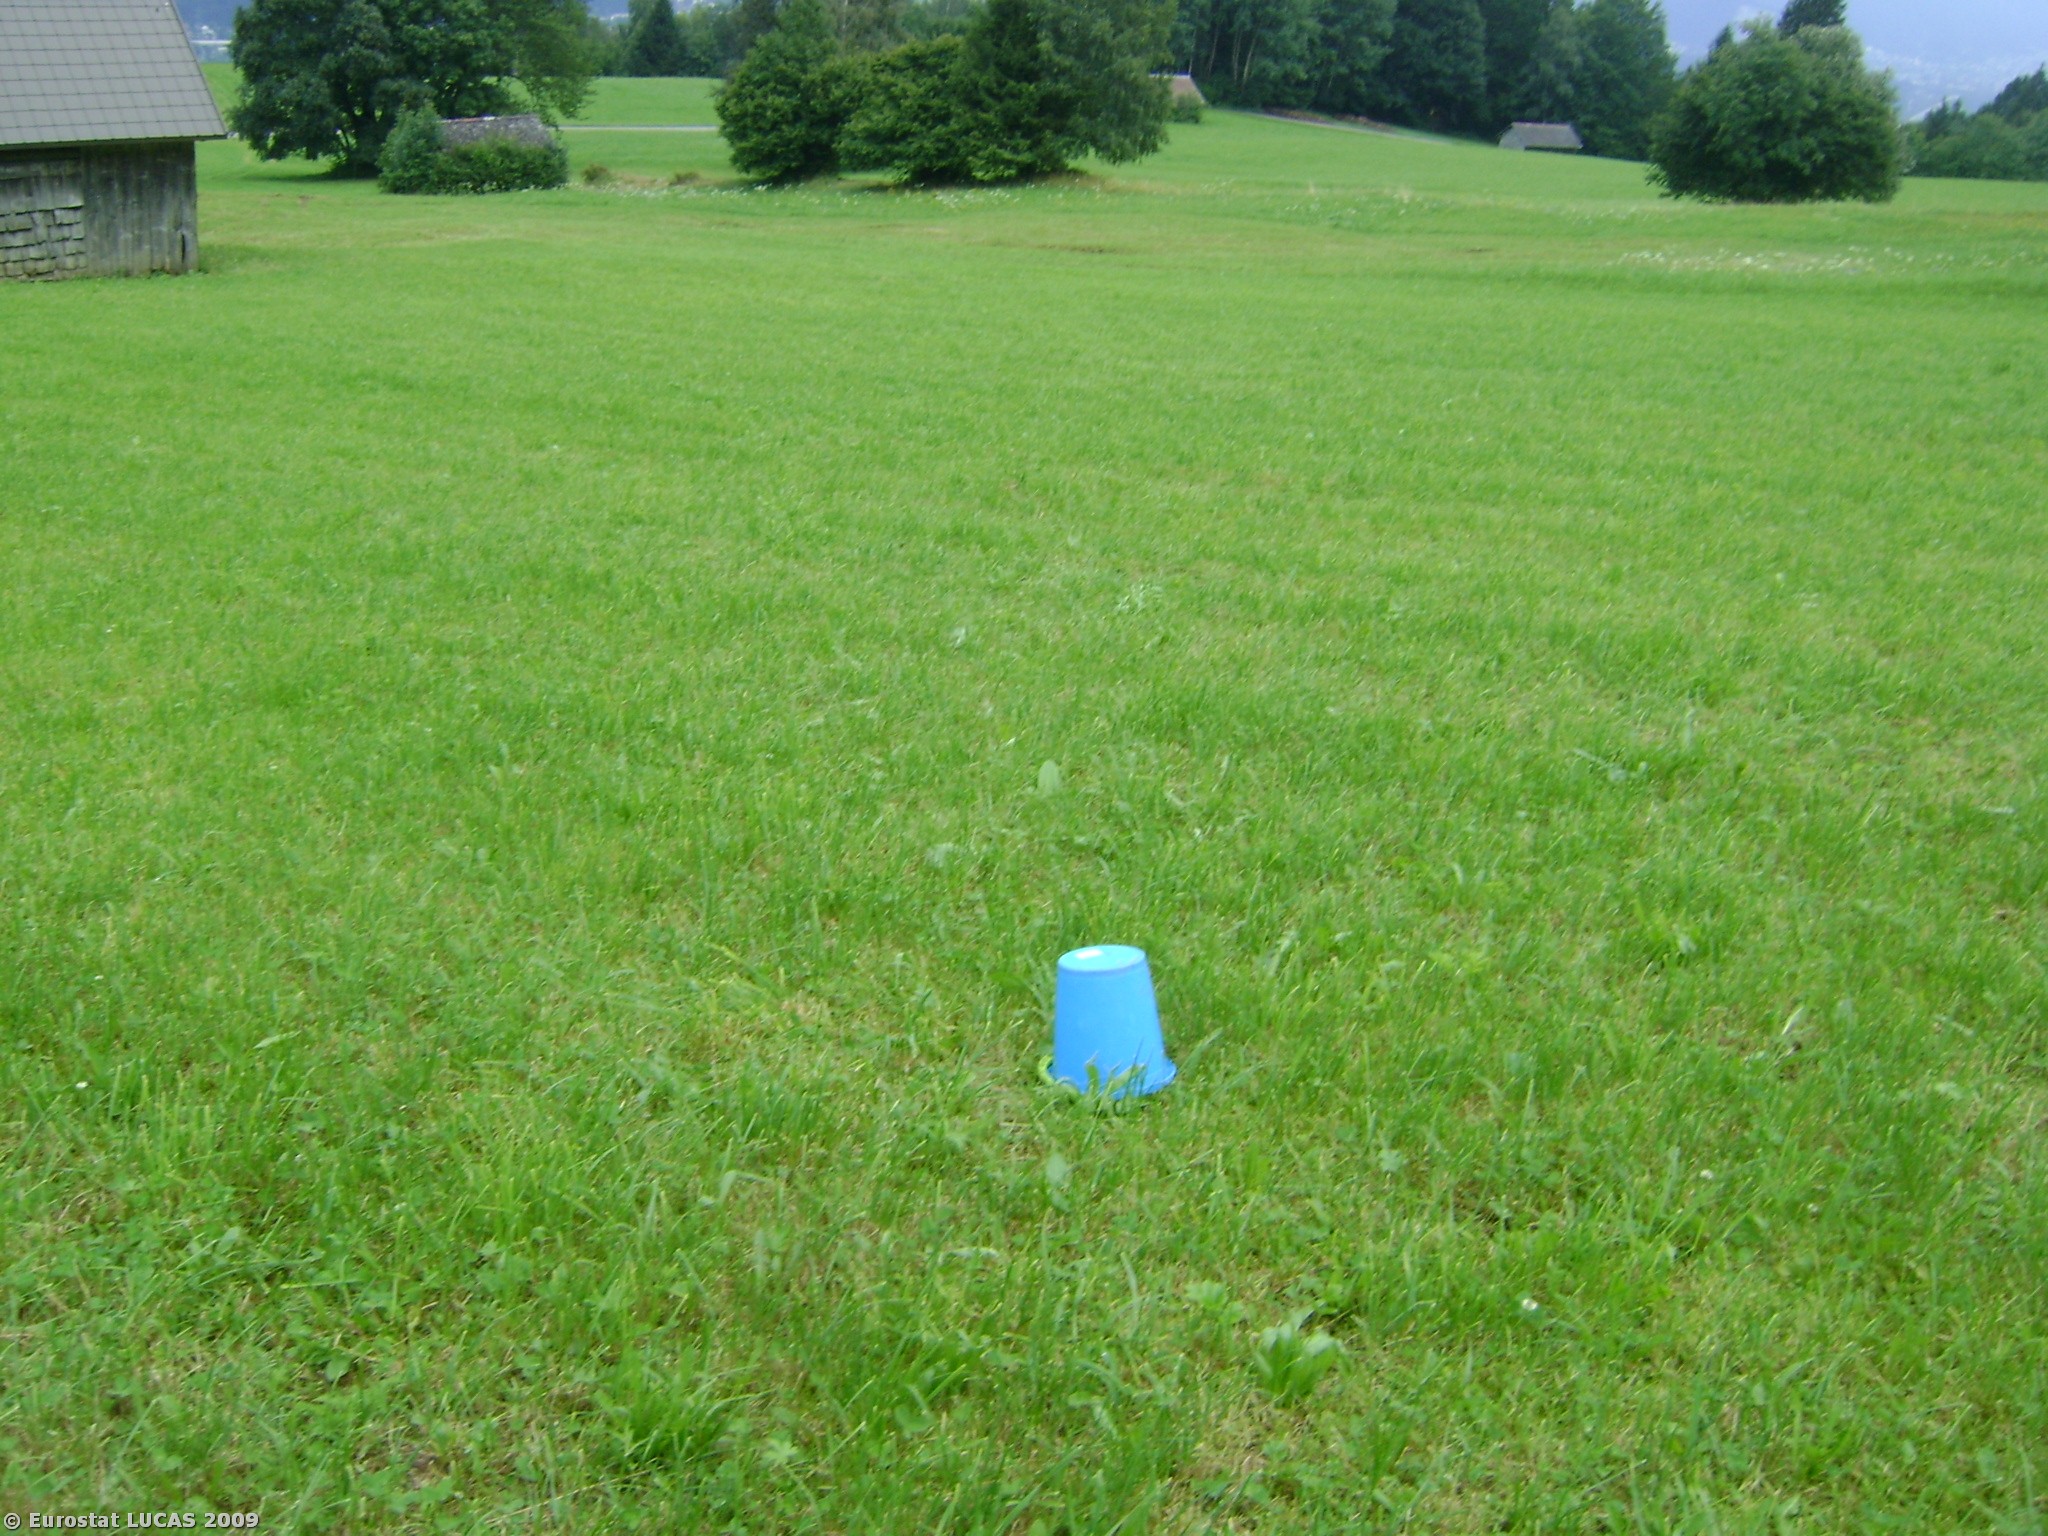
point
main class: Grassland
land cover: Grassland without tree/shrub cover
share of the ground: > 75 %
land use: Agriculture (excluding fallow land and kitchen gardens)
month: August
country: AT
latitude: 47.1791
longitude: 9.6705
